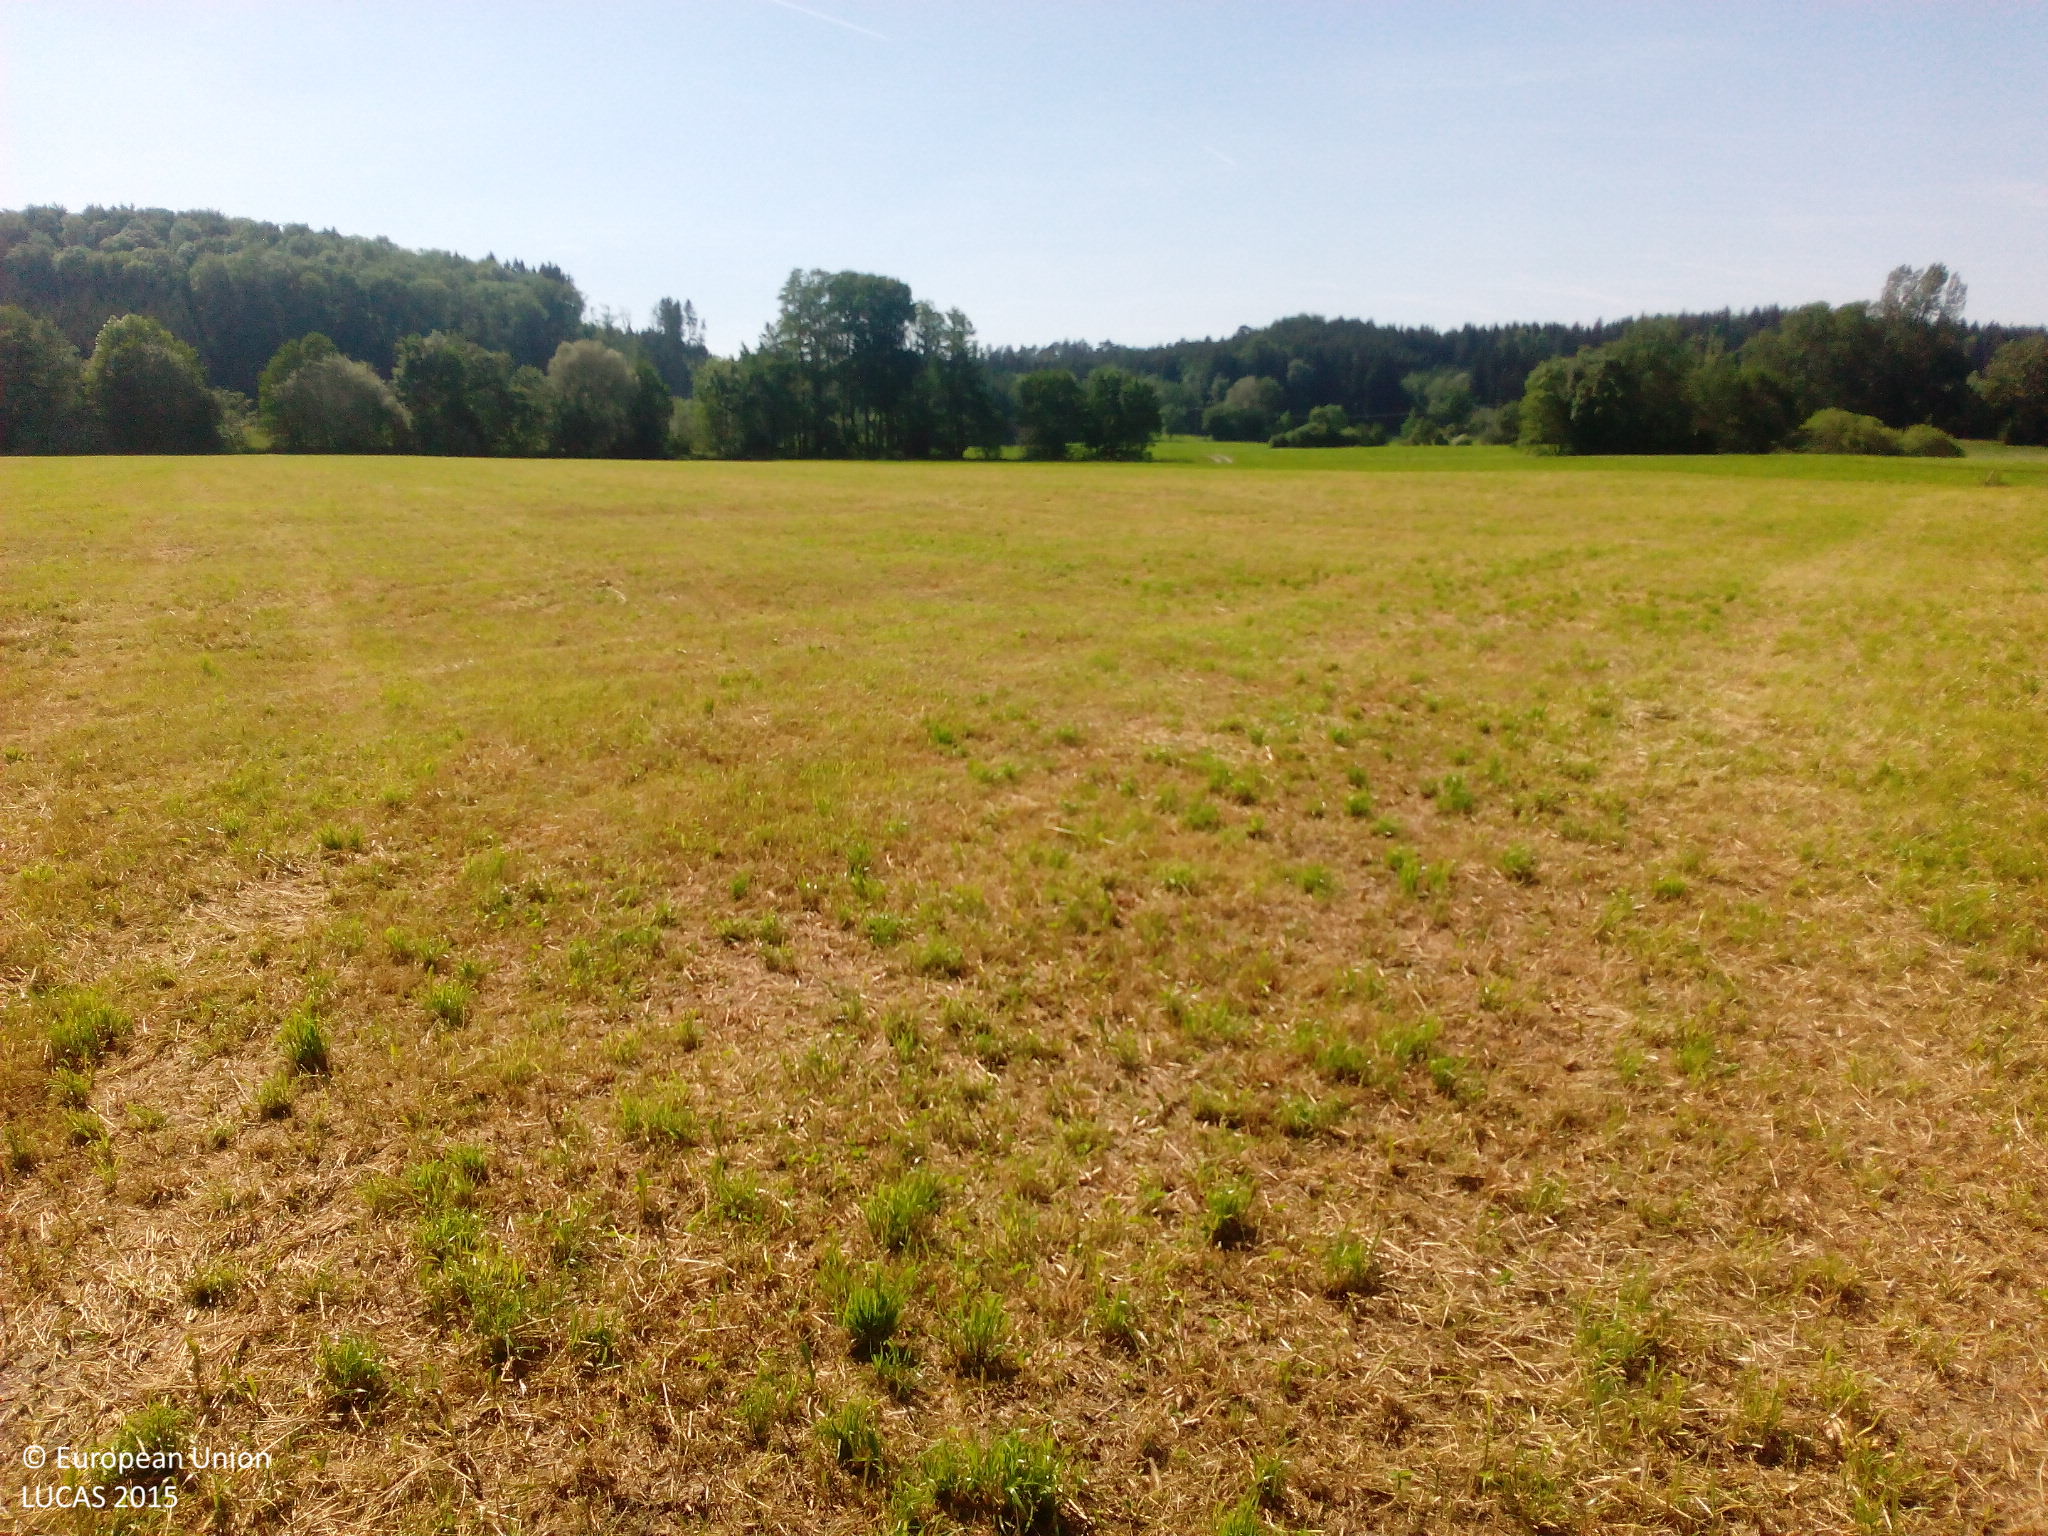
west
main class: Grassland
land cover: Grassland without tree/shrub cover
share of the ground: > 75 %
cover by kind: herbaceous plants 100 %
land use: Agriculture (excluding fallow land and kitchen gardens)
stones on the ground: < 10 %
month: June
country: DE
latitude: 47.9160
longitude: 10.6017
